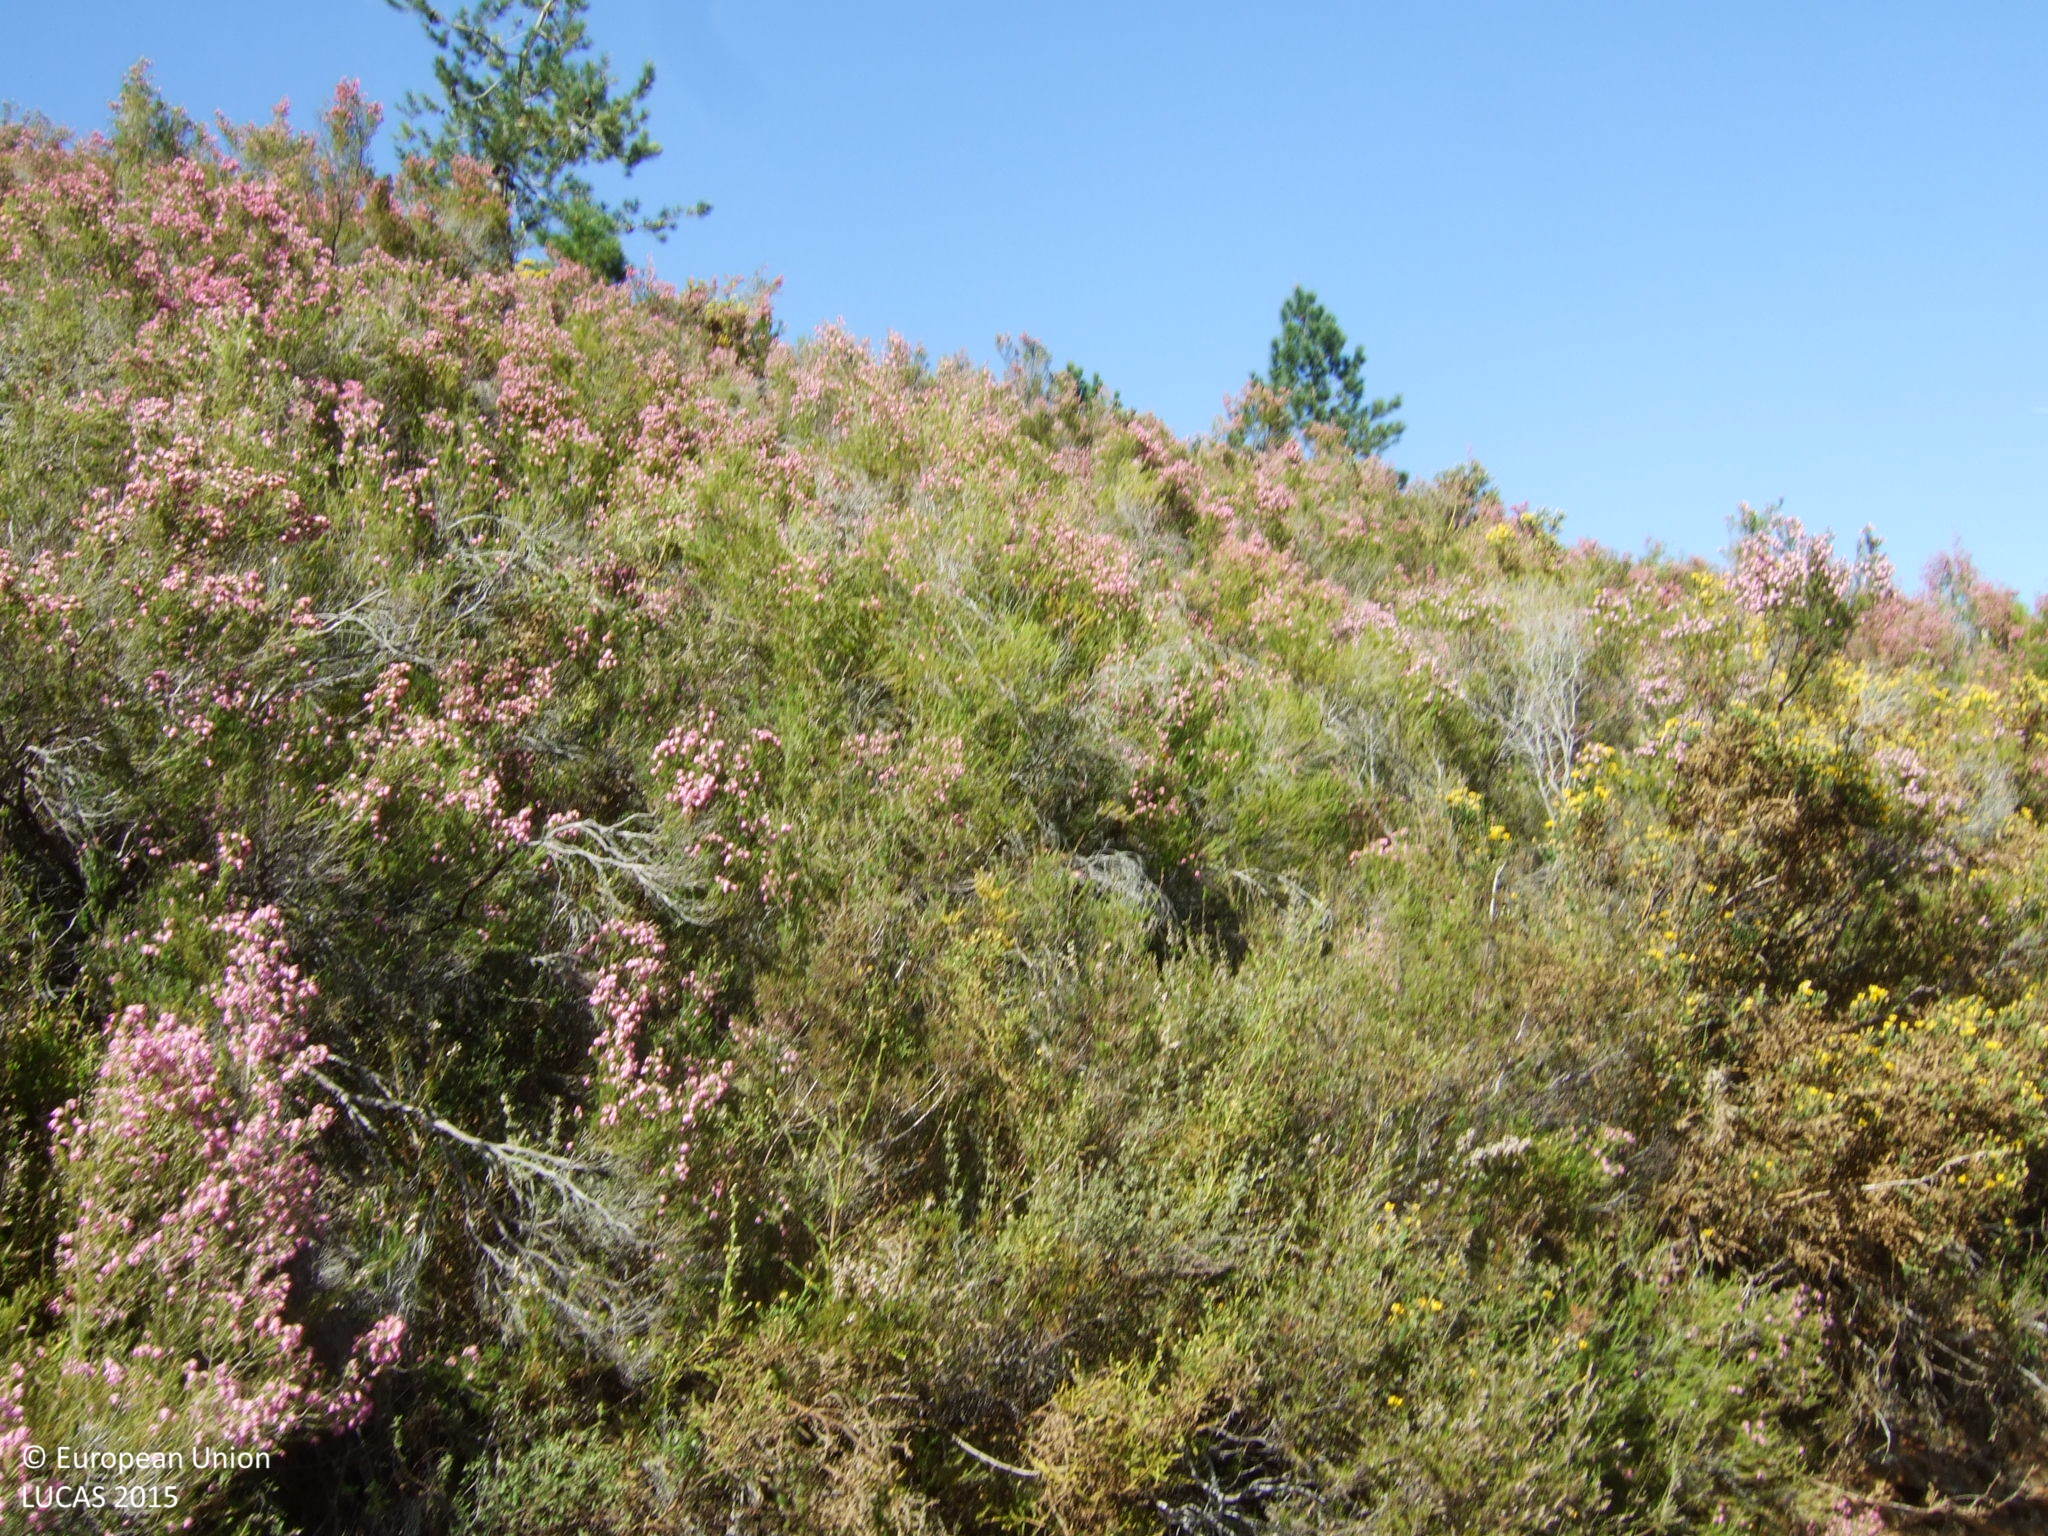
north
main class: Shrubland
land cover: Shrubland without tree cover
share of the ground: > 75 %
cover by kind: shrubs 100 %
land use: Semi-natural and natural areas not in use
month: April
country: ES
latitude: 42.6136
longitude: -7.2653
